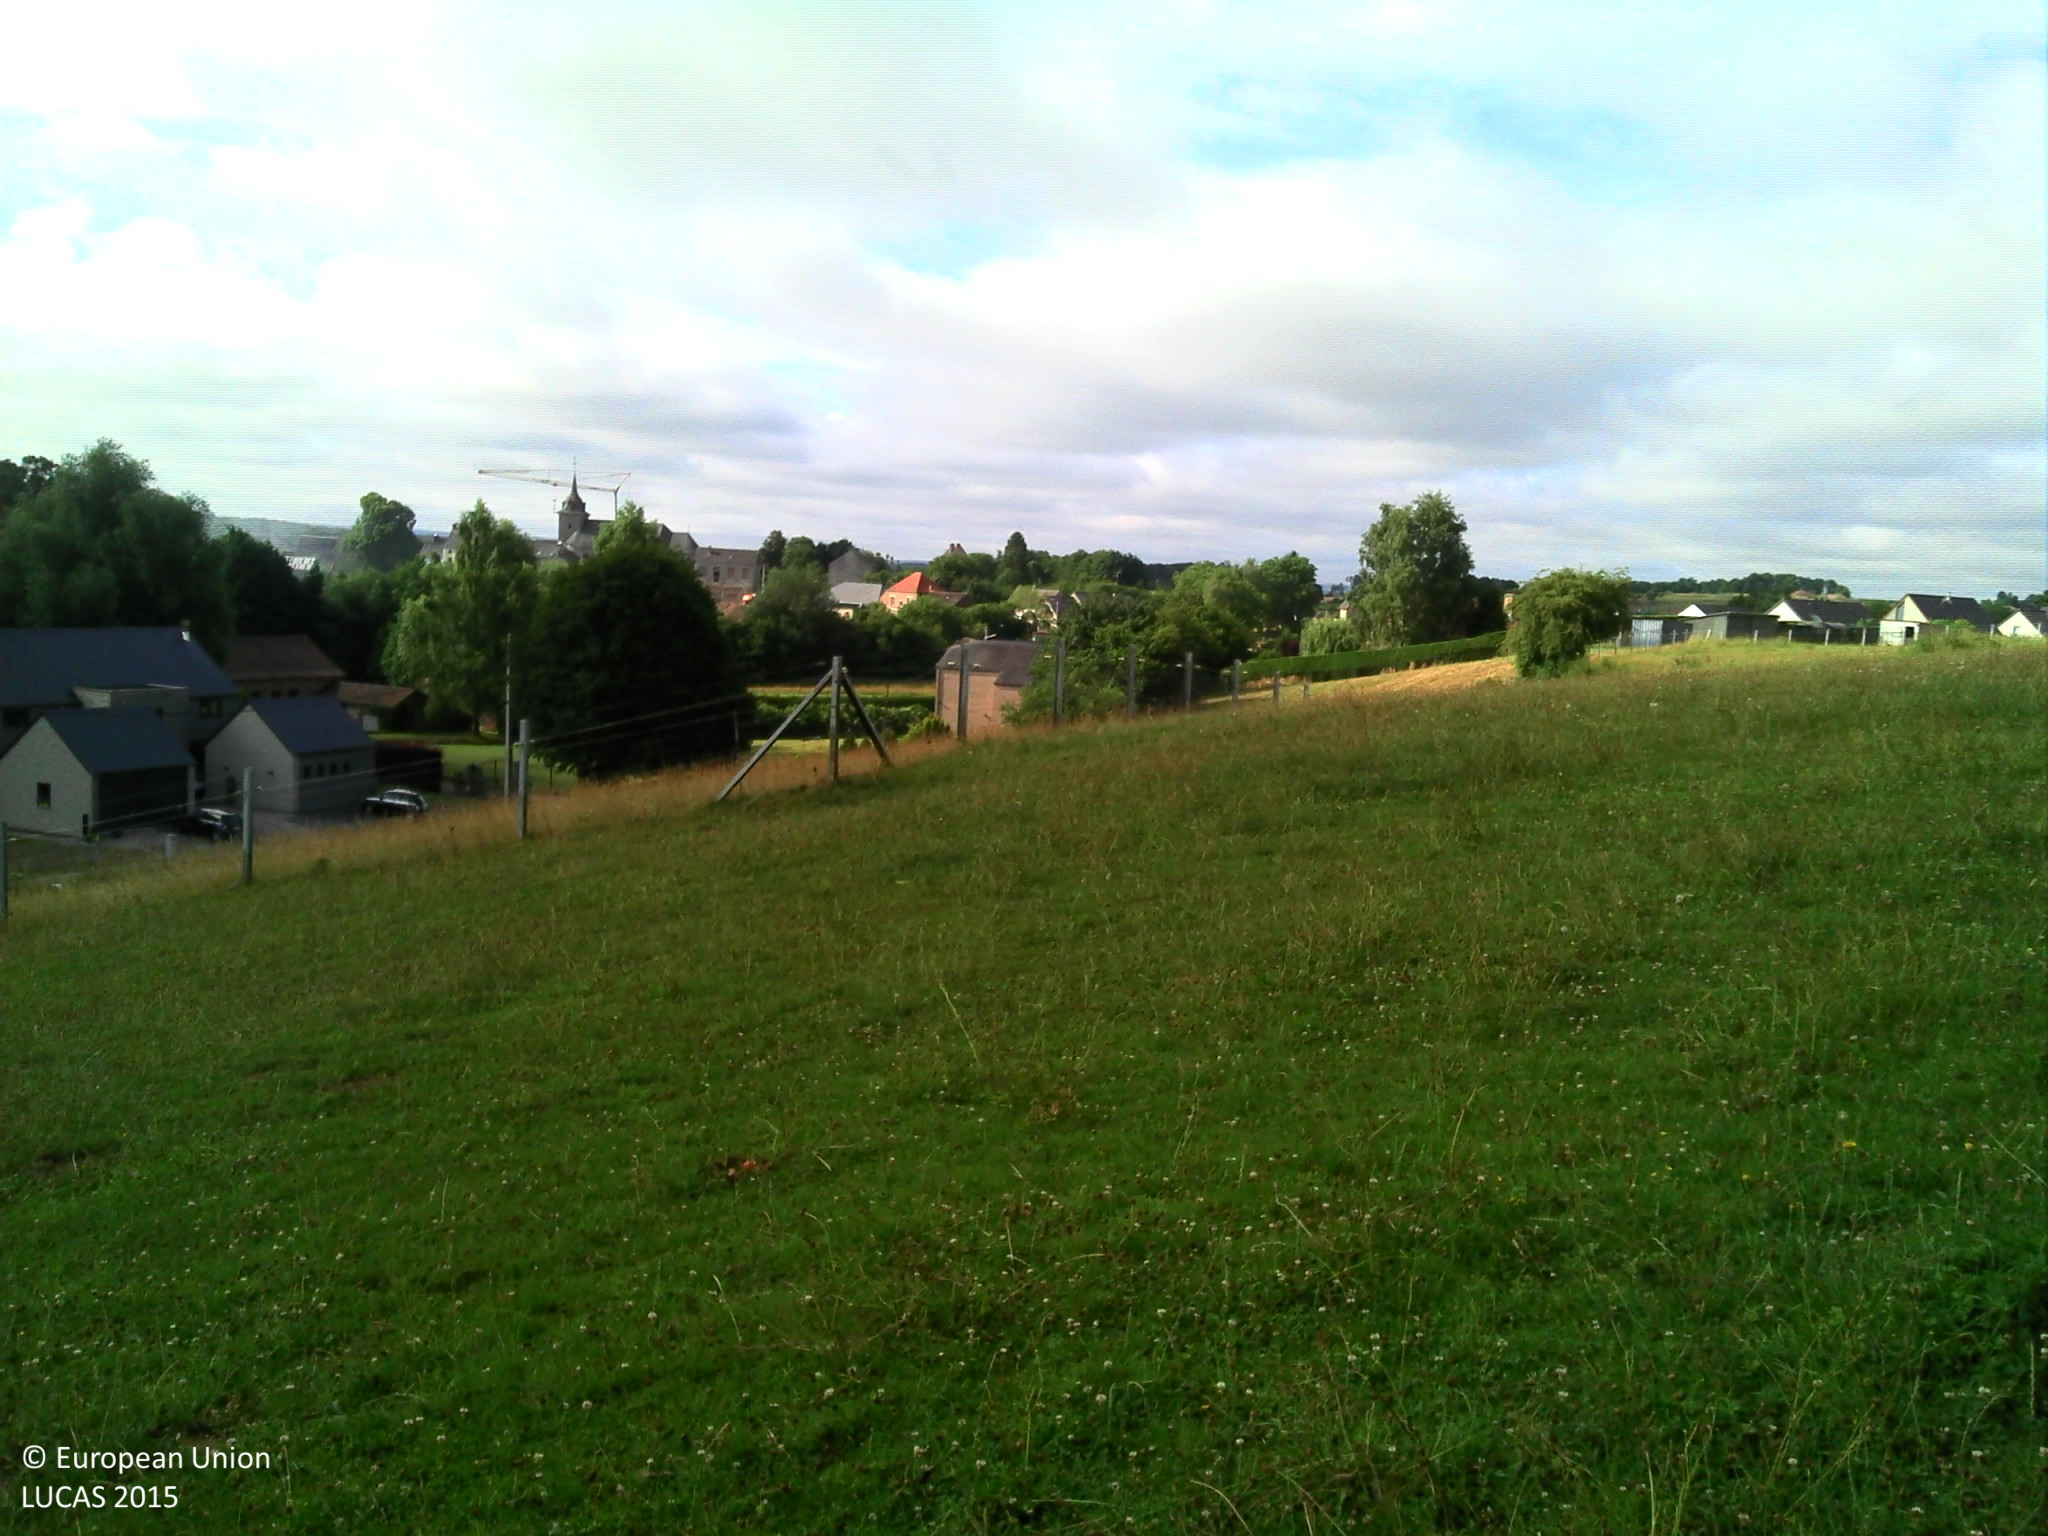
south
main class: Grassland
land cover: Grassland without tree/shrub cover
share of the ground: > 75 %
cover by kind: herbaceous plants 100 %
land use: Agriculture (excluding fallow land and kitchen gardens)
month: July
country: BE
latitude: 50.1787
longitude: 4.5207
